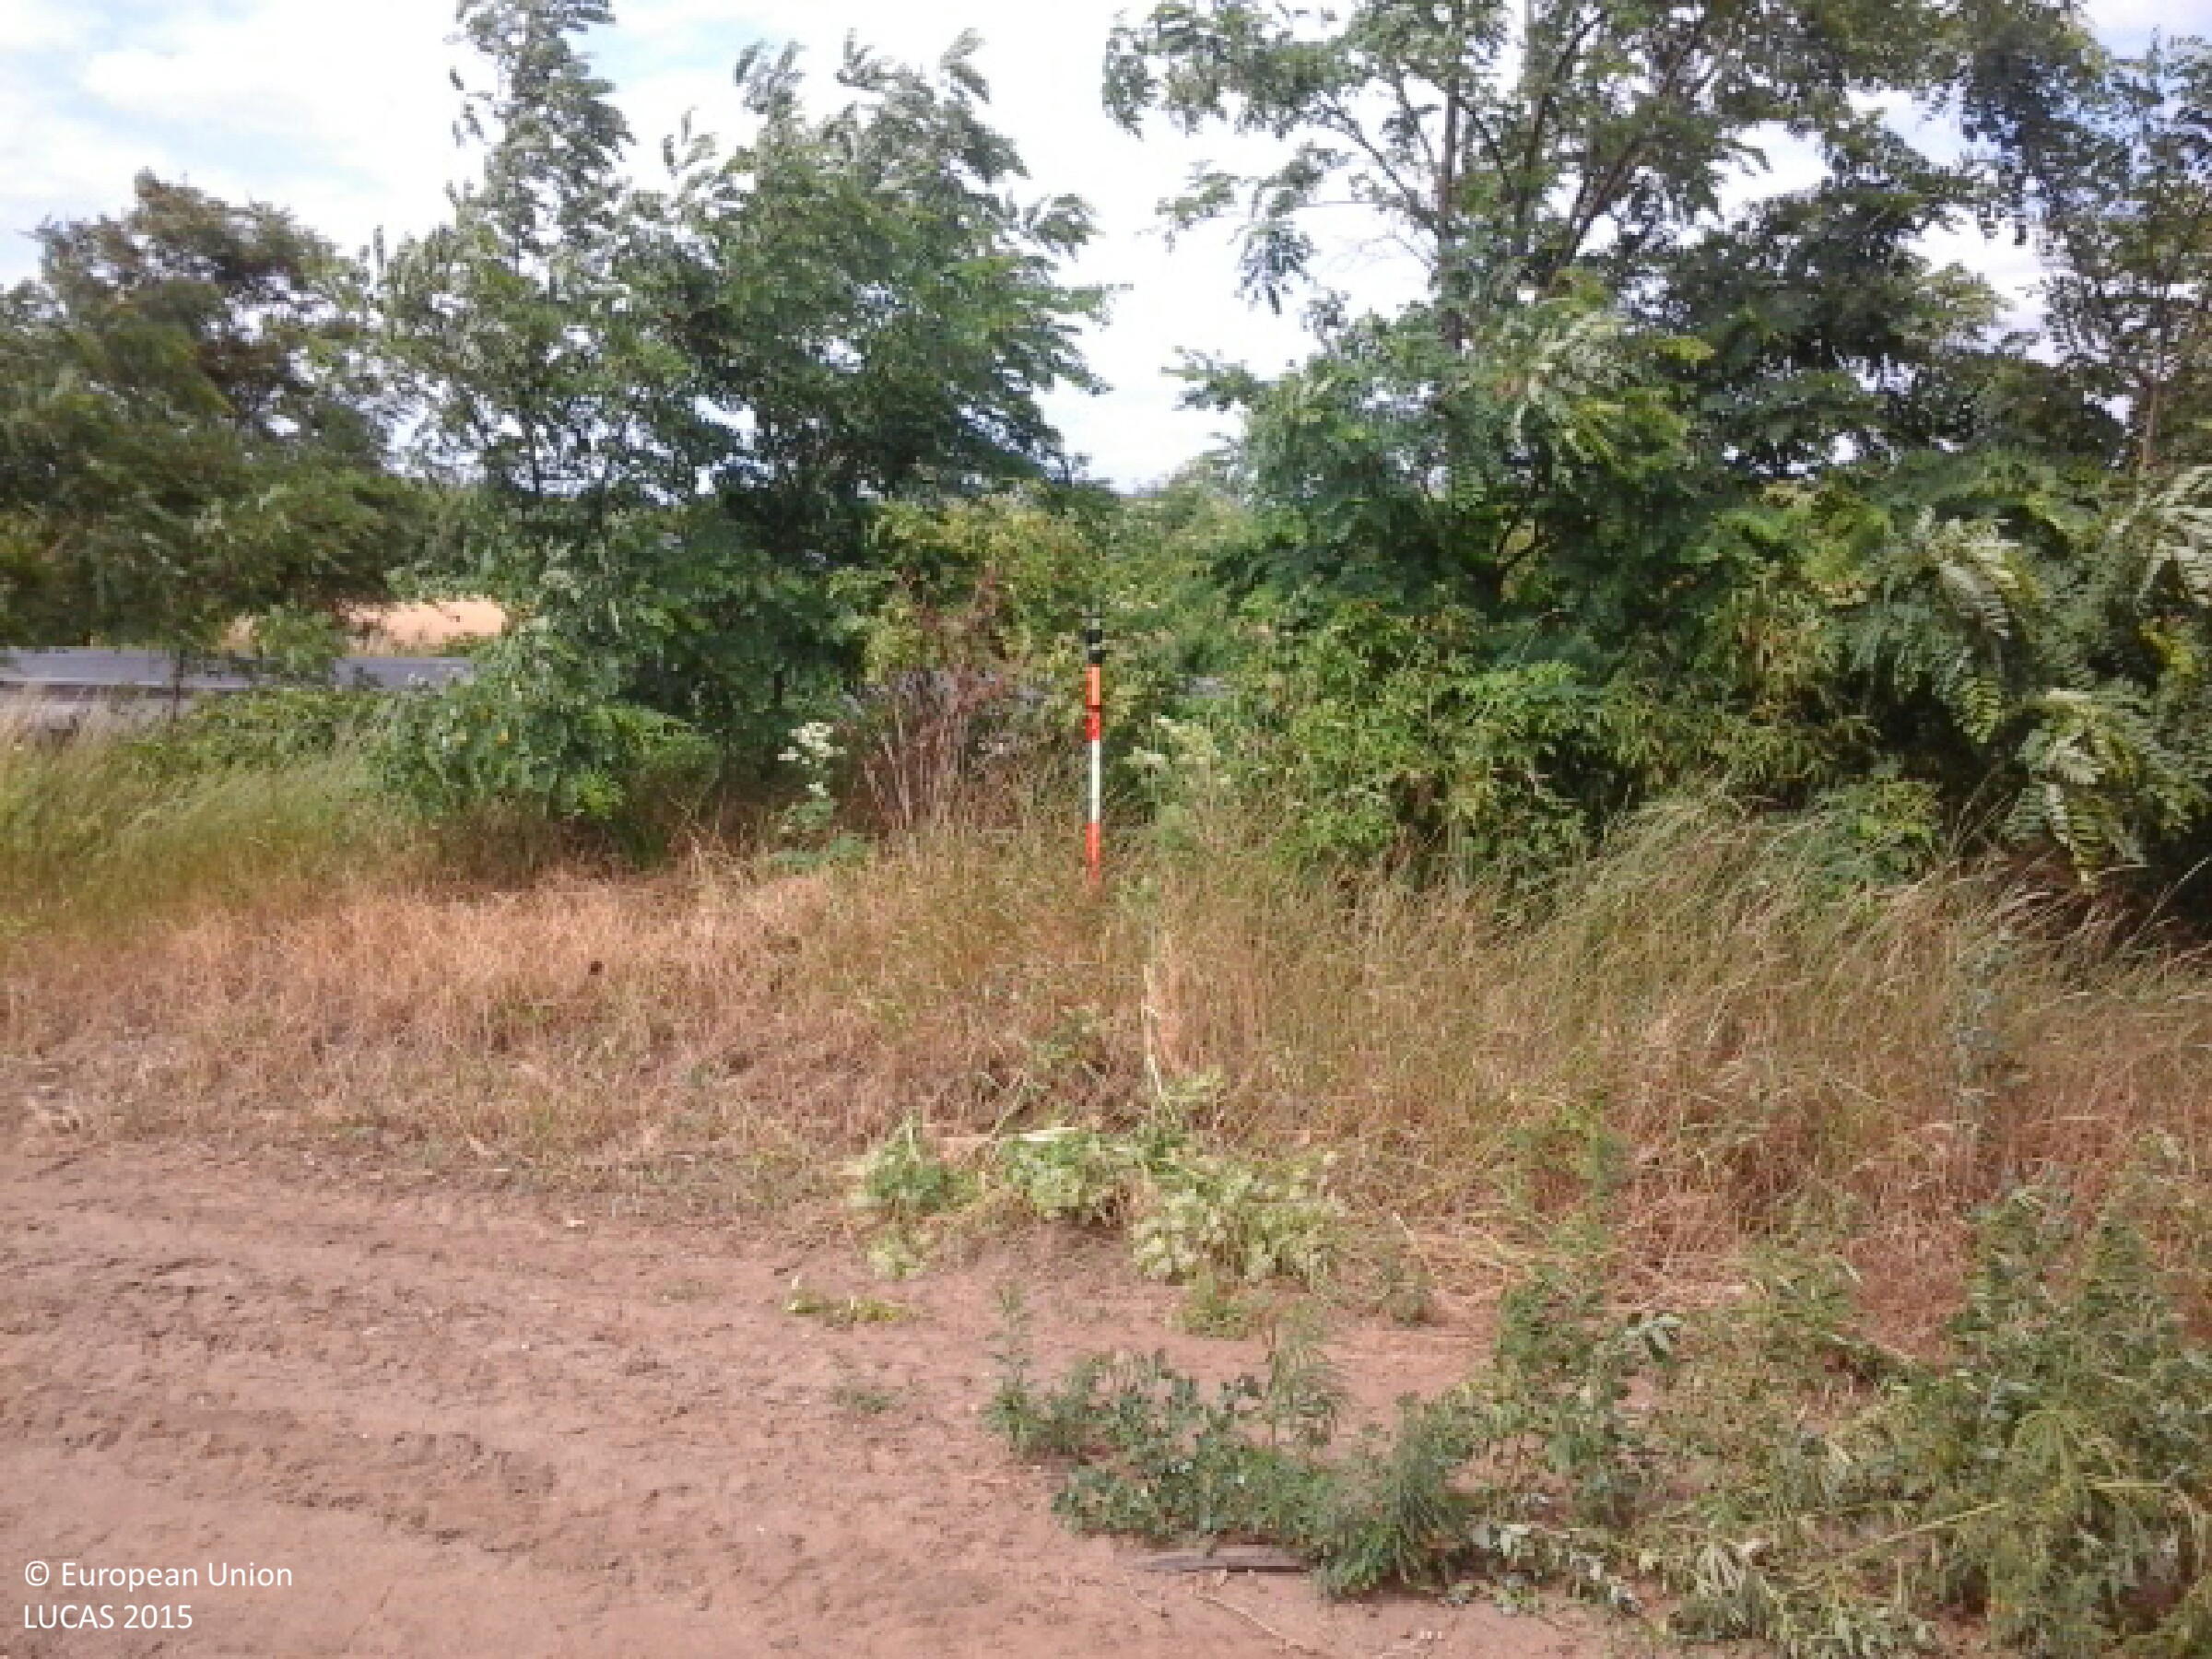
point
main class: Shrubland
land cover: Shrubland with sparse tree cover
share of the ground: 50 - 75 %
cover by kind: shrubs 70 %, herbaceous plants 25 %, broadleaved forest trees 5 %
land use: Road transport
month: June
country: HU
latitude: 48.0717
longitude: 21.5208
